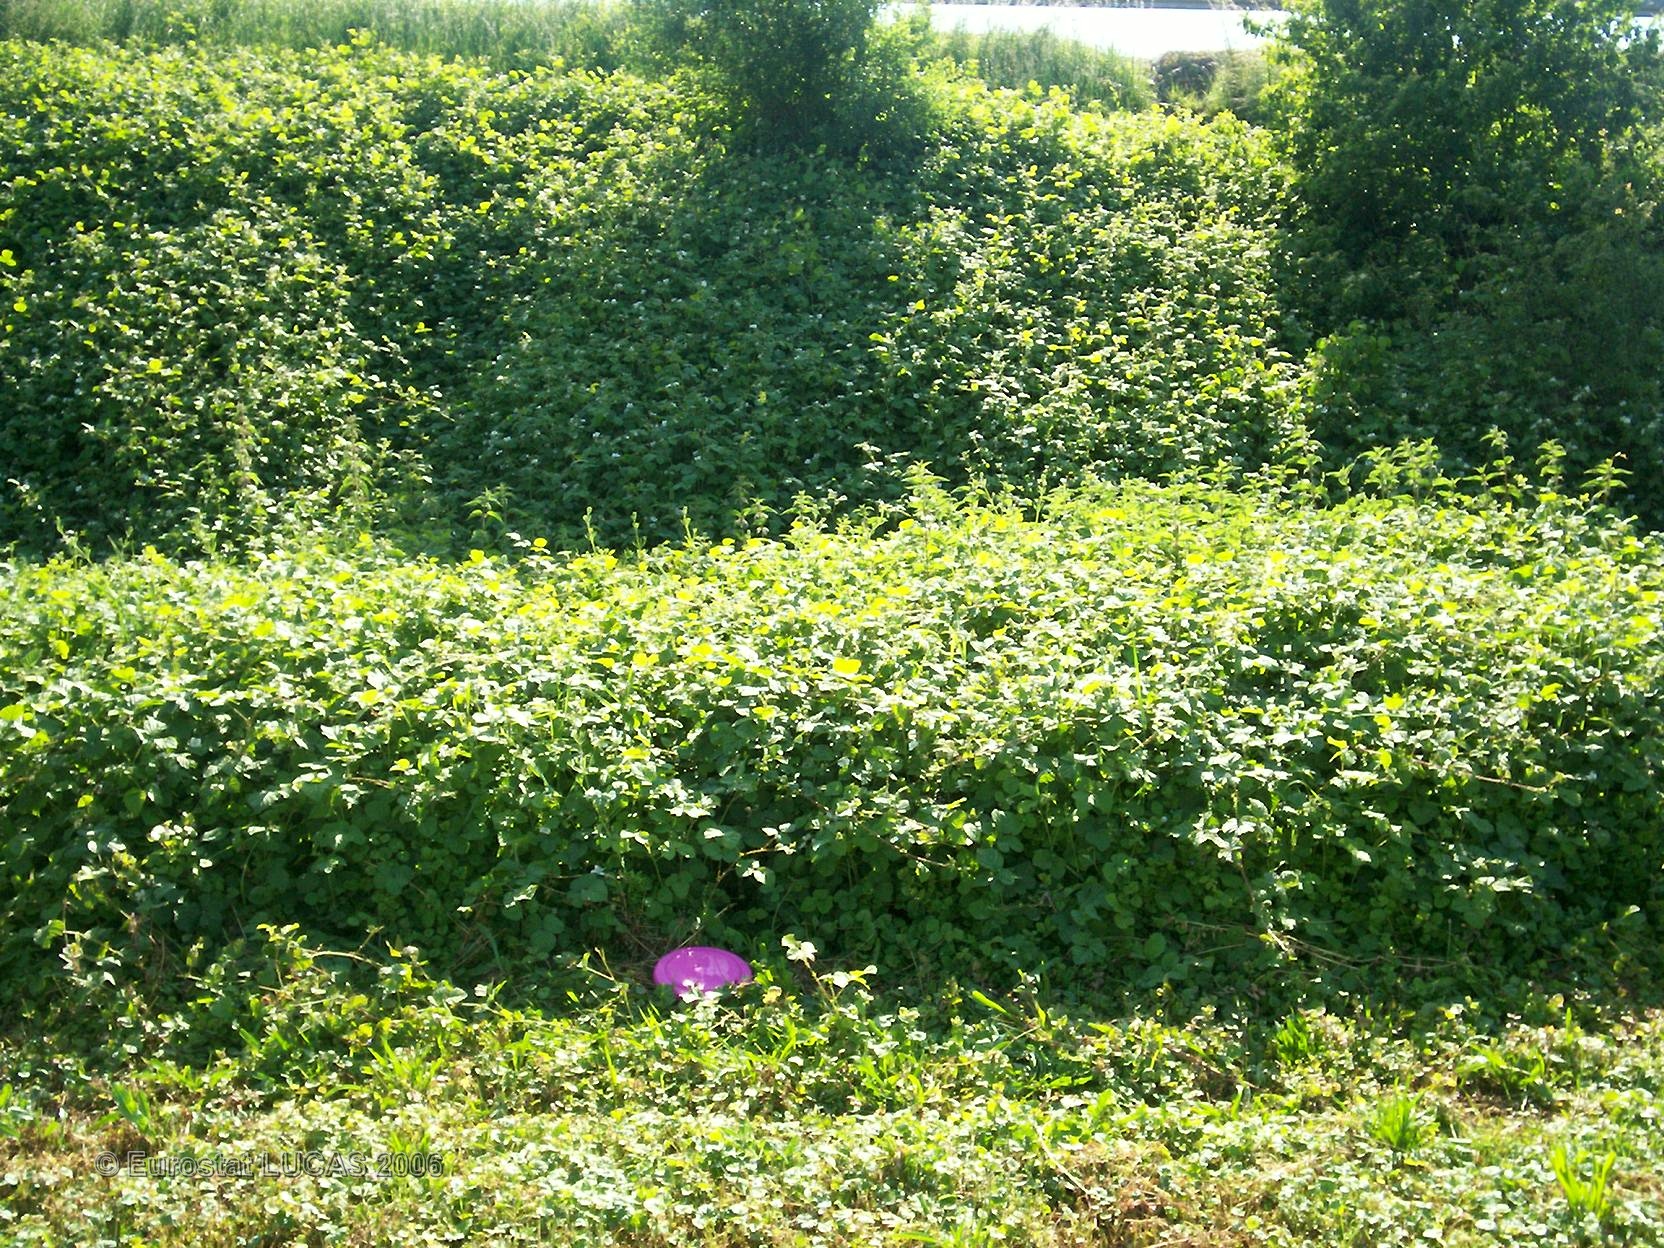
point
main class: Cropland
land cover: Lucerne
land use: Agriculture (excluding fallow land and kitchen gardens)
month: June
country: FR
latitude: 48.7237
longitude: 4.6278
